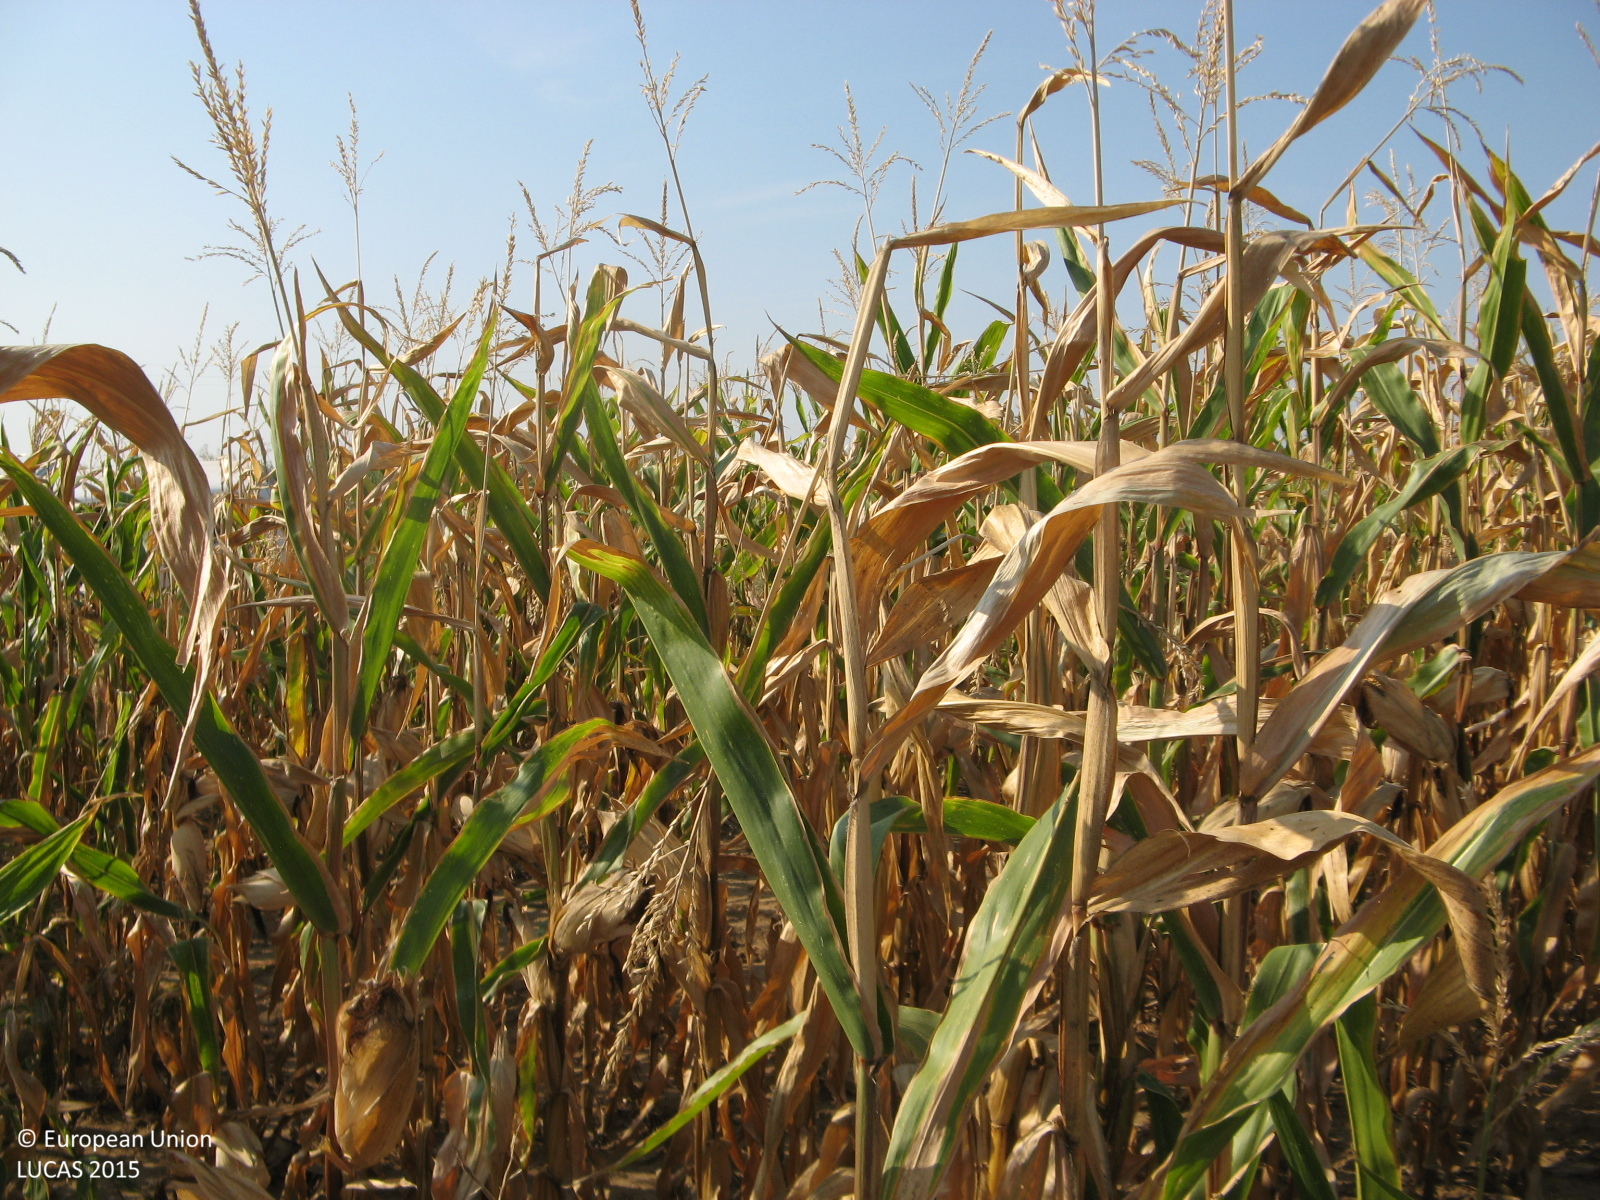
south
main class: Cropland
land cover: Maize
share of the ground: > 75 %
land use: Agriculture (excluding fallow land and kitchen gardens)
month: September
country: BG
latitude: 43.5899
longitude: 25.6803
